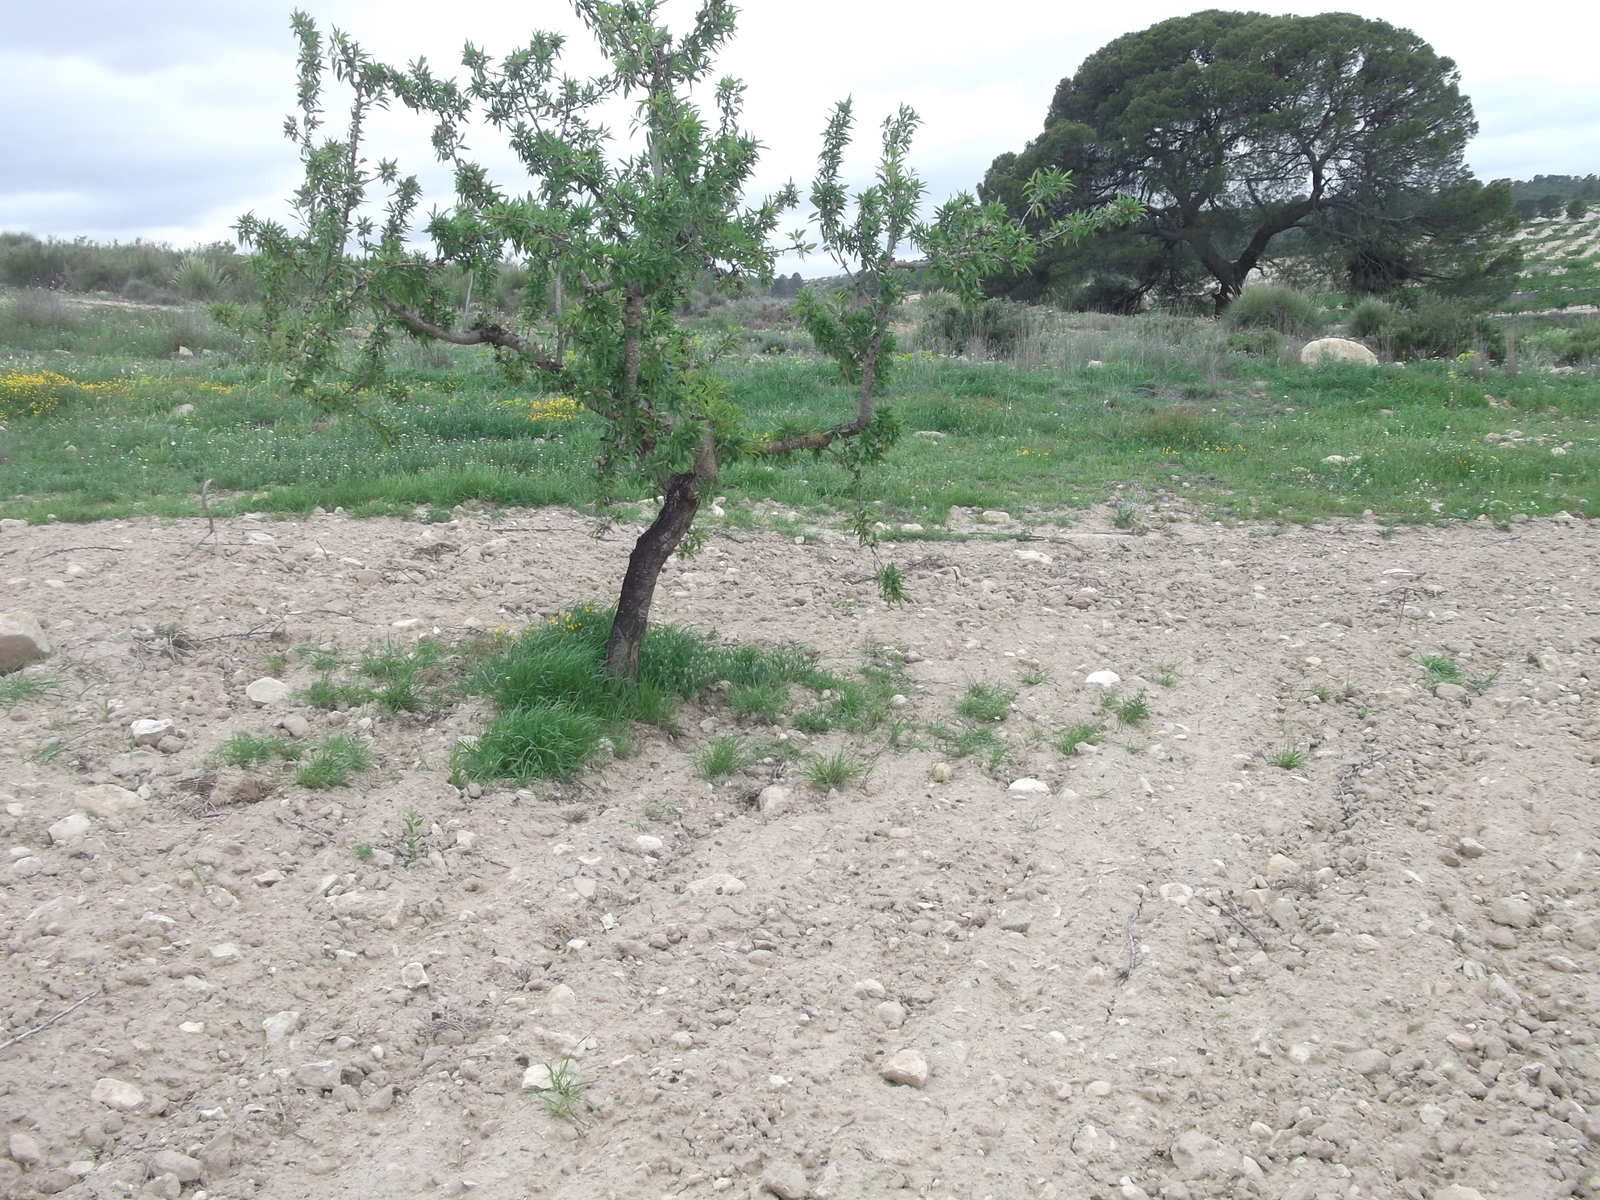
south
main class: Cropland
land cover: Nuts trees
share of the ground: 10 - 25 %
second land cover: Spontaneously vegetated surfaces
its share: < 10 %
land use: Agriculture (excluding fallow land and kitchen gardens)
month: April
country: ES
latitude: 38.1189
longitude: -1.5652
